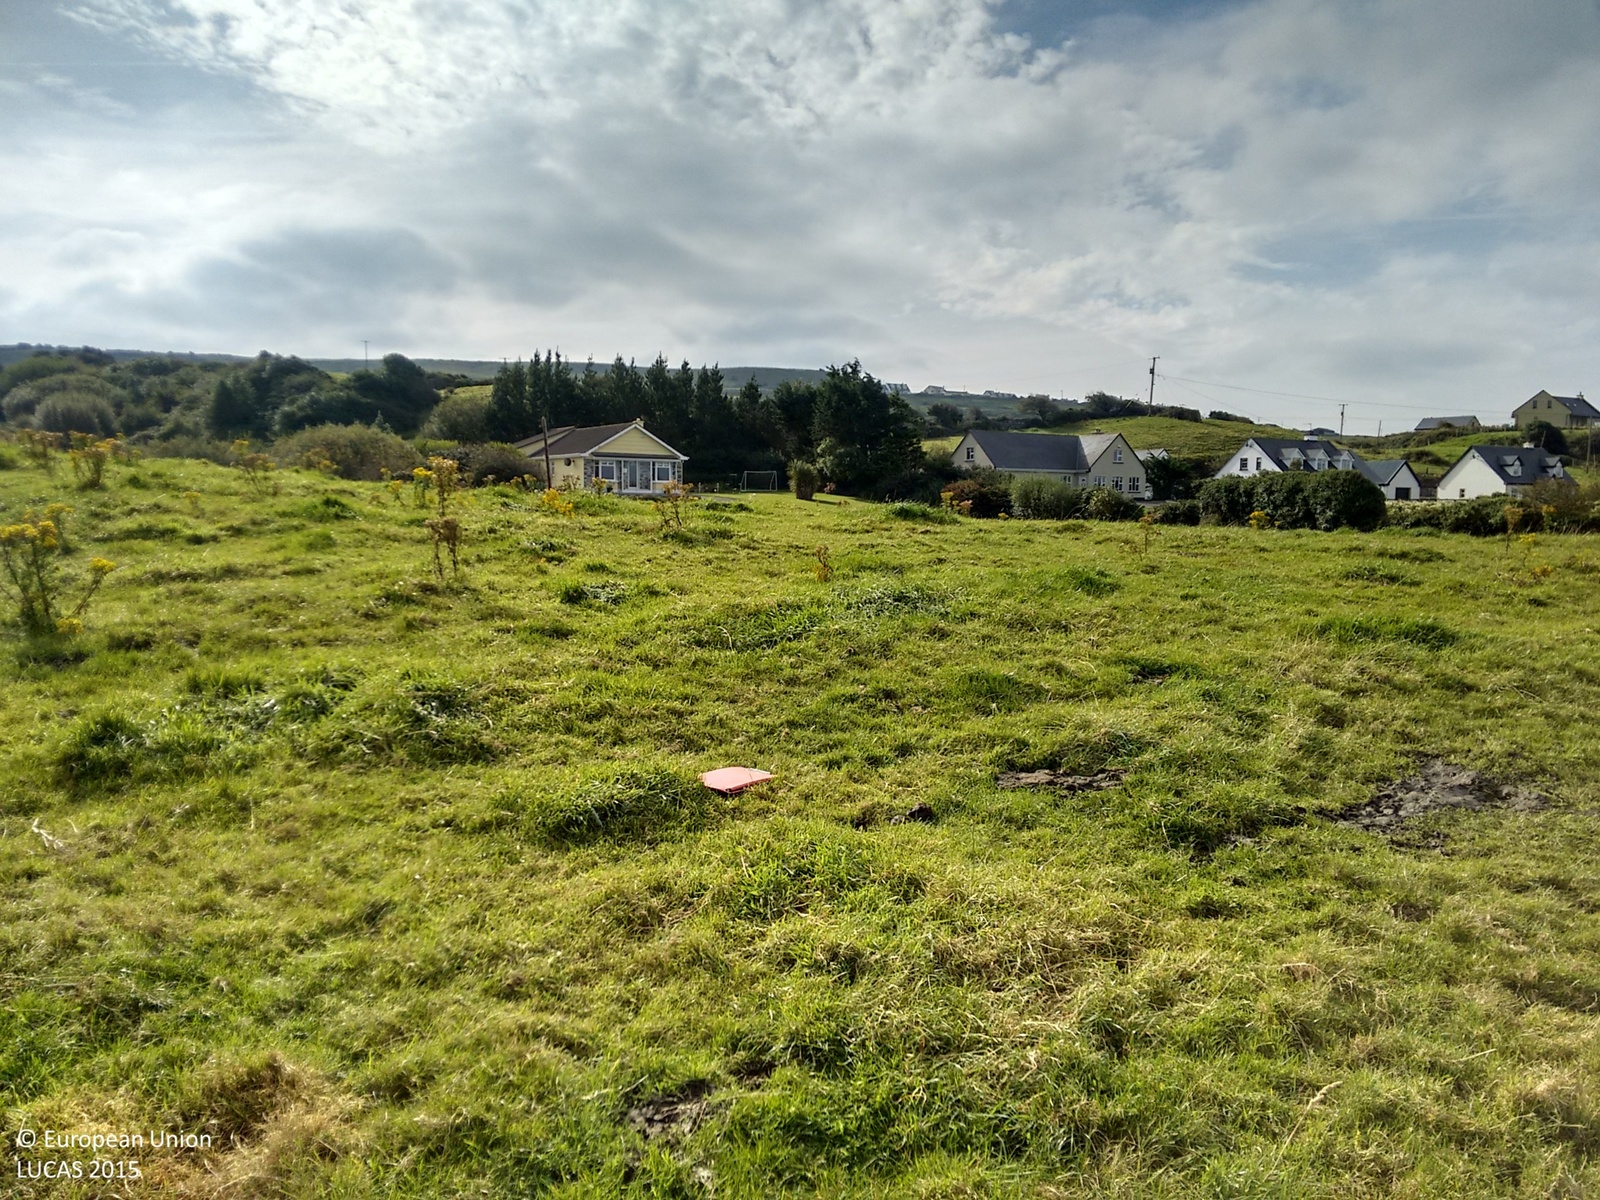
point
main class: Grassland
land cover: Grassland without tree/shrub cover
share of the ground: > 75 %
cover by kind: herbaceous plants 100 %
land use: Agriculture (excluding fallow land and kitchen gardens)
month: September
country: IE
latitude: 52.9357
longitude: -9.3145
